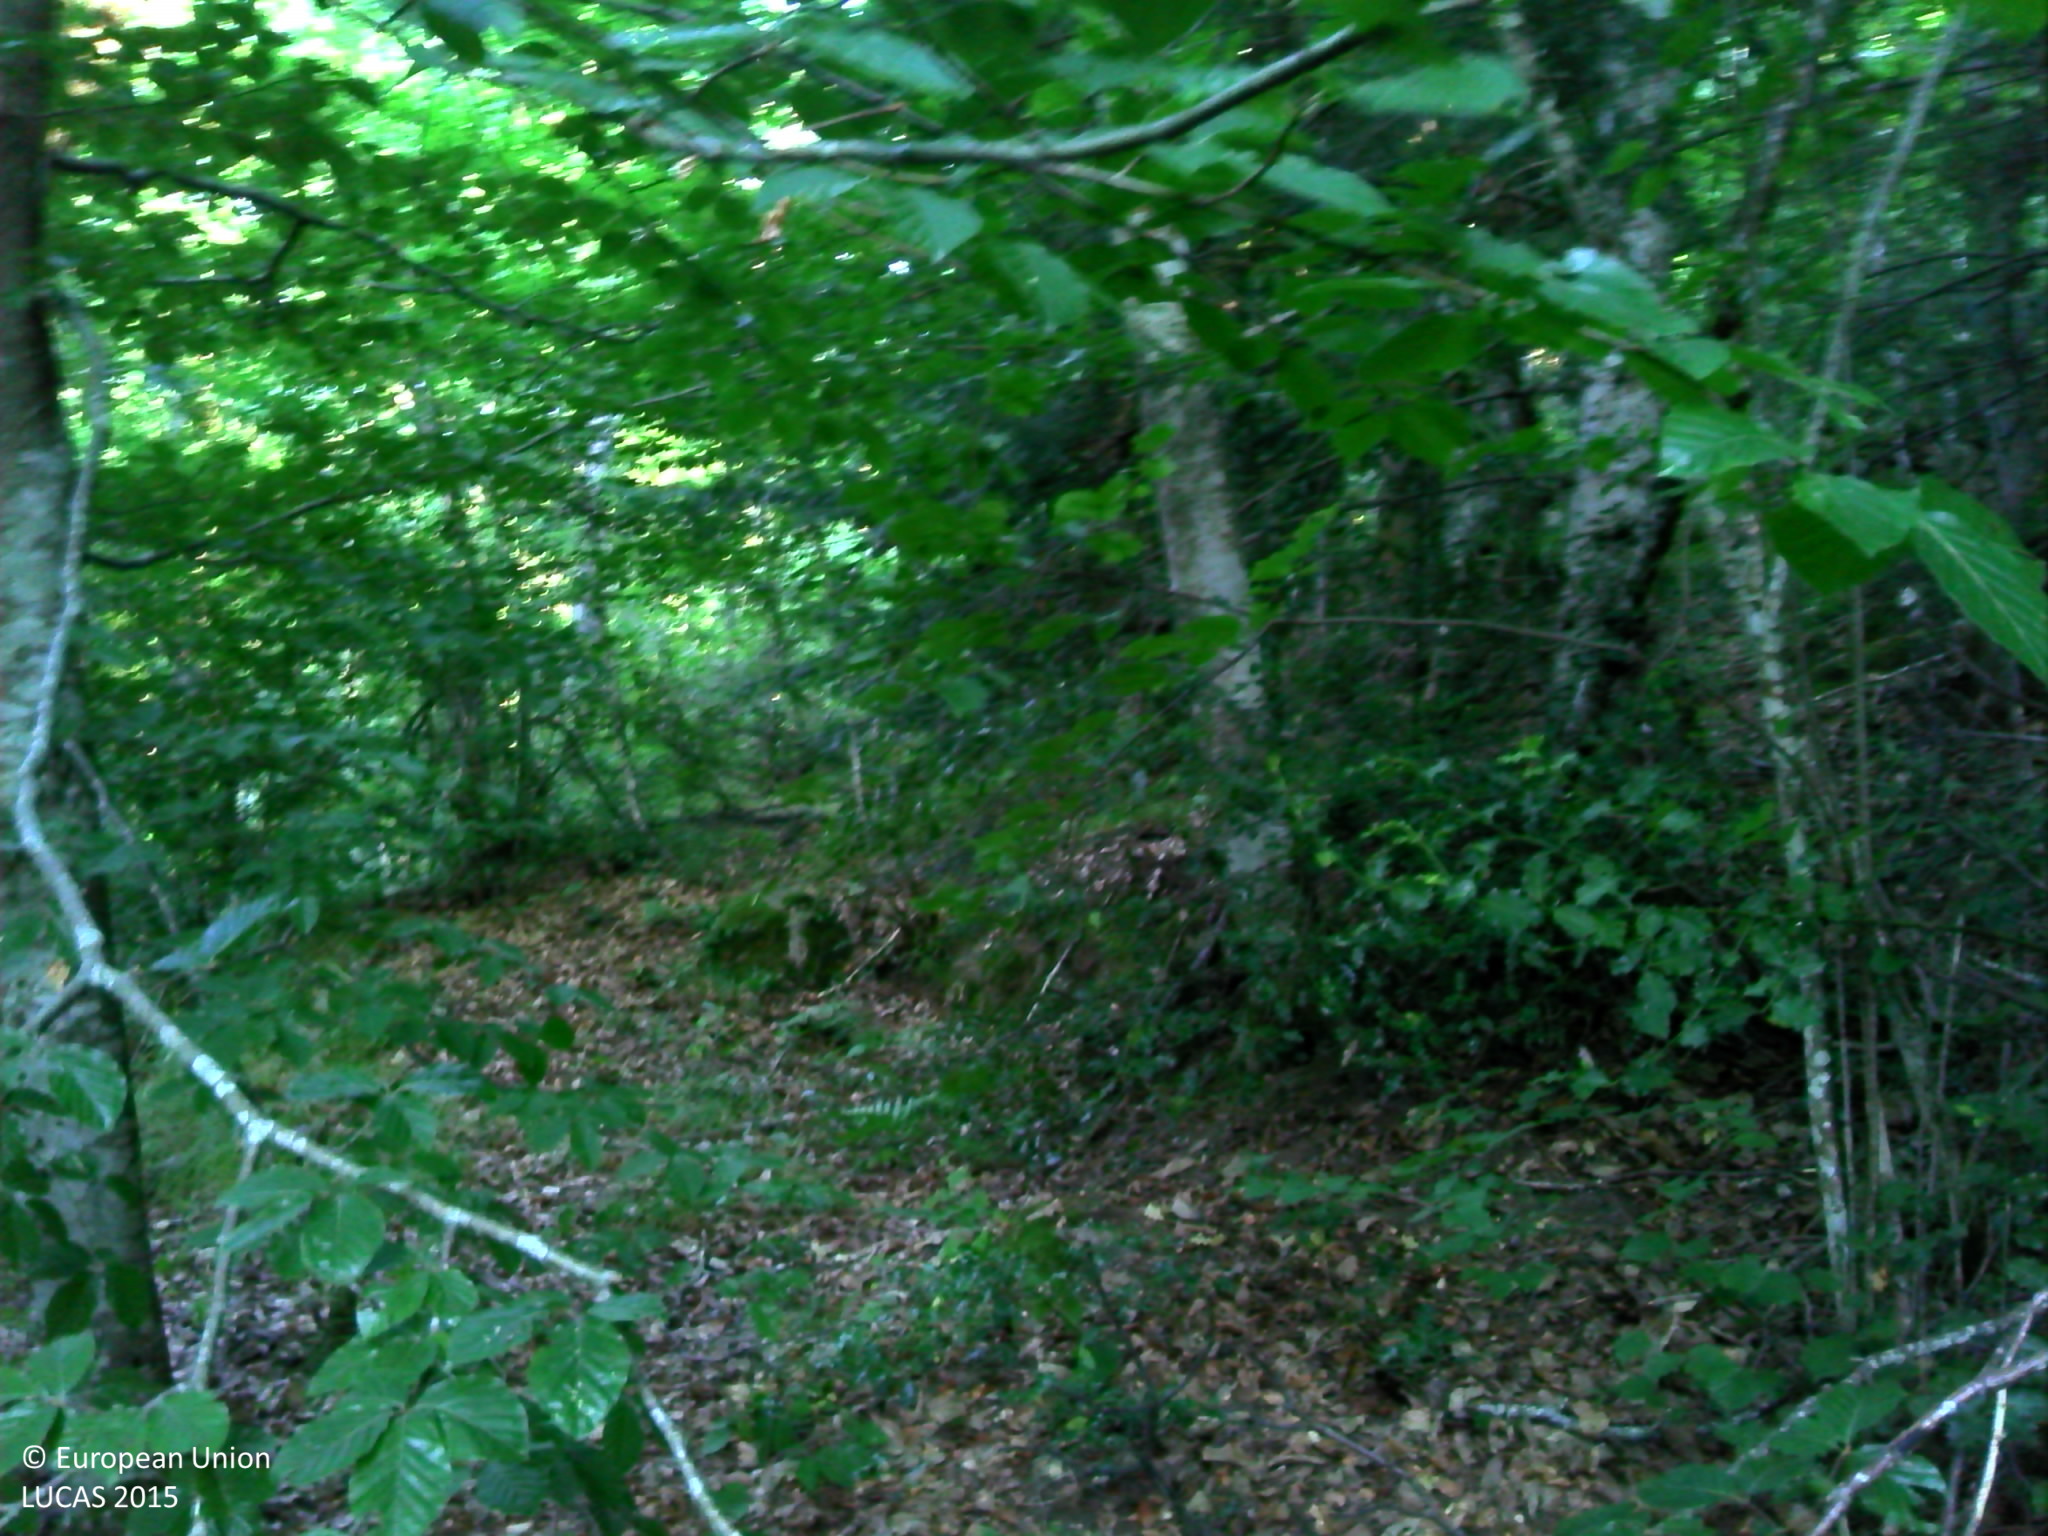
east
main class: Woodland
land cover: Spruce dominated mixed woodland
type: mountainous beech forest
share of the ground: > 75 %
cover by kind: broadleaved forest trees 60 %, coniferous forest trees 40 %
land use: Semi-natural and natural areas not in use
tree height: > 5 m
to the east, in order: Spruce dominated mixed woodland; Dry stone walls; Paved roads, cycling and walking lanes; Spruce dominated mixed woodland; Dry stone walls; Paved roads, cycling and walking lanes; Spruce dominated mixed woodland
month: July
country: FR
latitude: 42.7214
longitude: 1.8150
